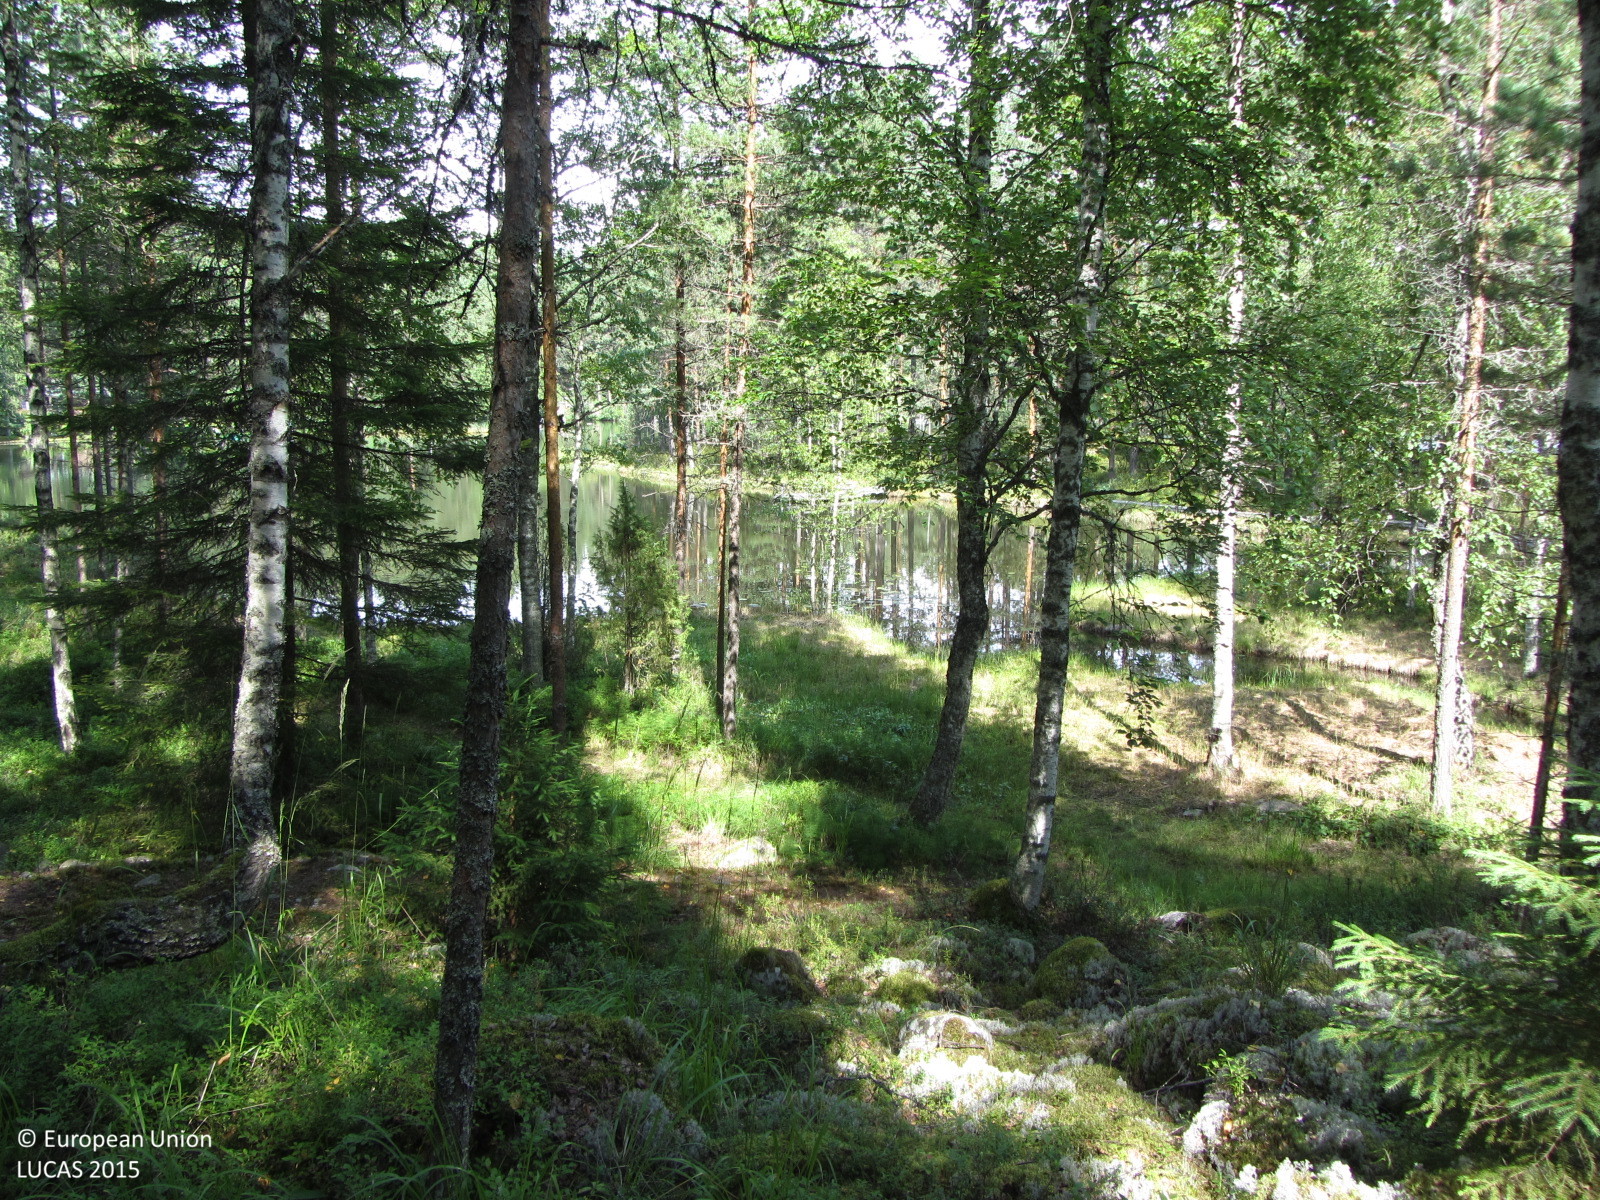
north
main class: Woodland
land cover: Pine dominated mixed woodland
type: boreal forest
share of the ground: 50 - 75 %
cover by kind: coniferous forest trees 30 %, broadleaved forest trees 30 %, shrubs 20 %, lichens and mosses 15 %, unconsolidated bare surface 5 %
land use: Forestry
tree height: > 5 m
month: July
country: FI
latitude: 60.6311
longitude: 24.3790
